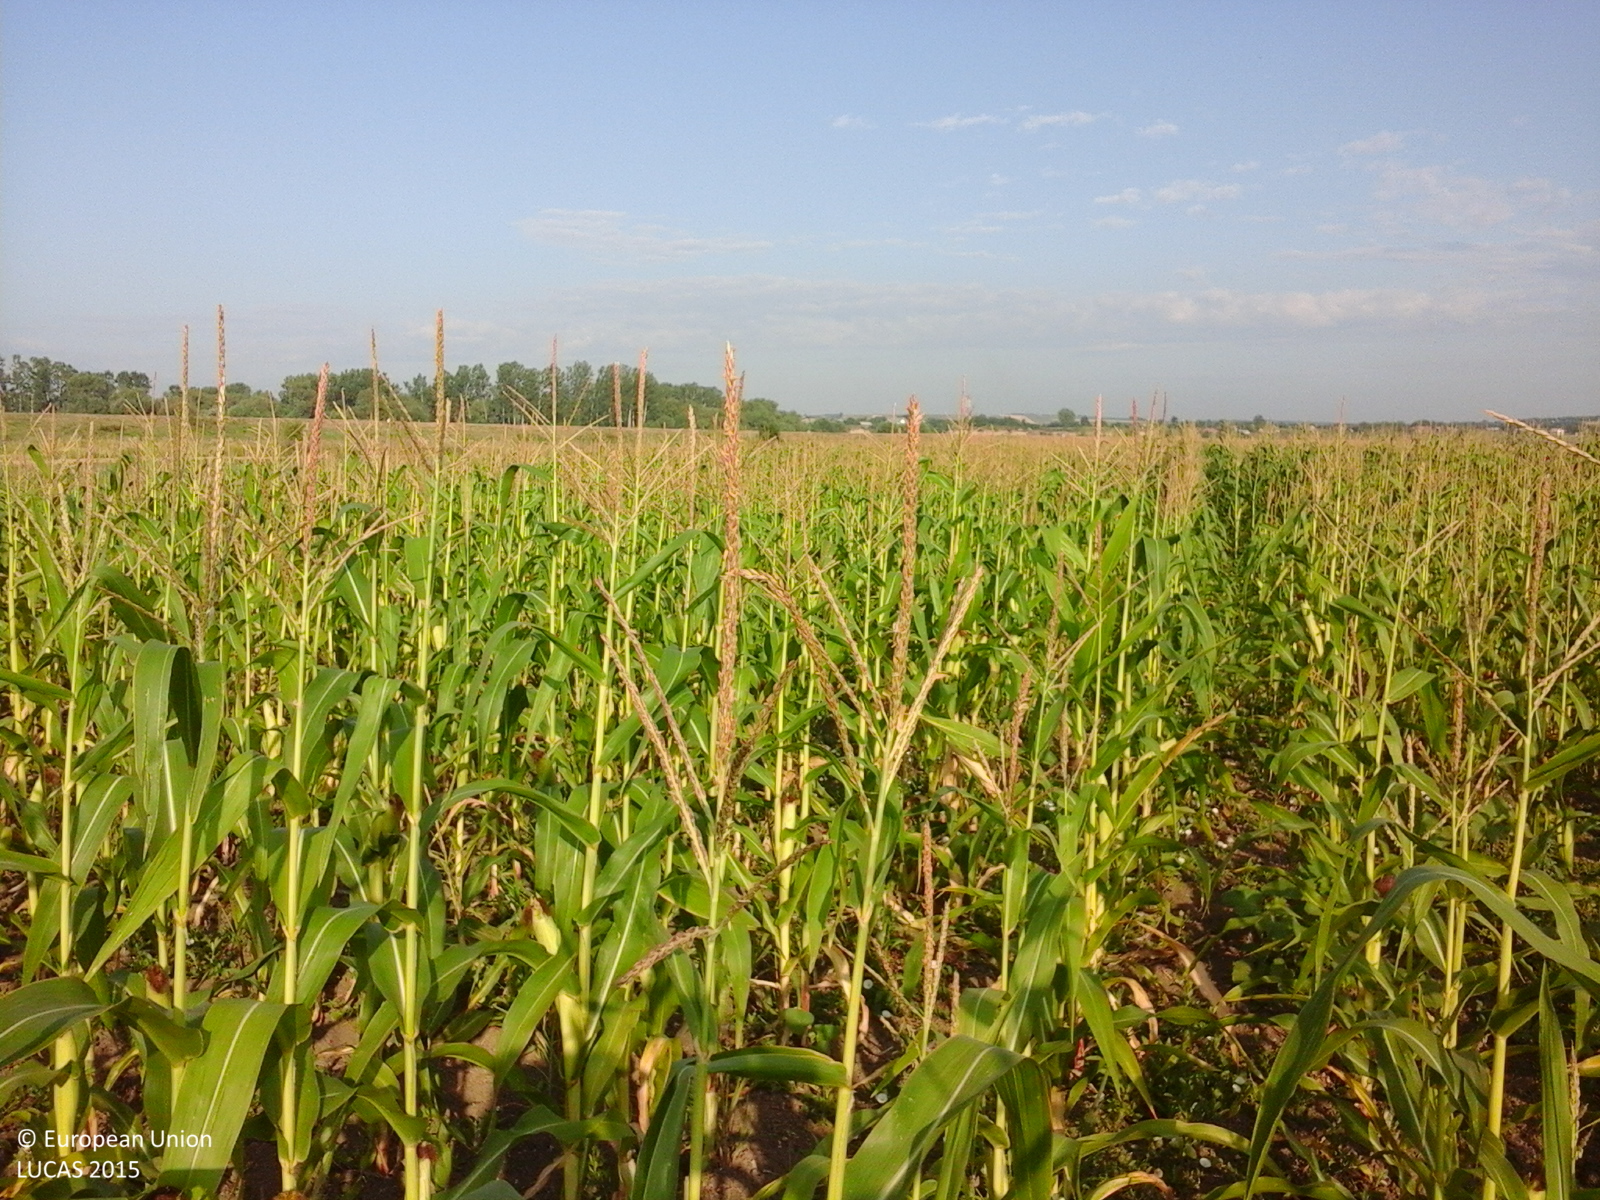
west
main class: Cropland
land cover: Maize
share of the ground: > 75 %
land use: Agriculture (excluding fallow land and kitchen gardens)
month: July
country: RO
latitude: 46.2921
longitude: 28.1604
